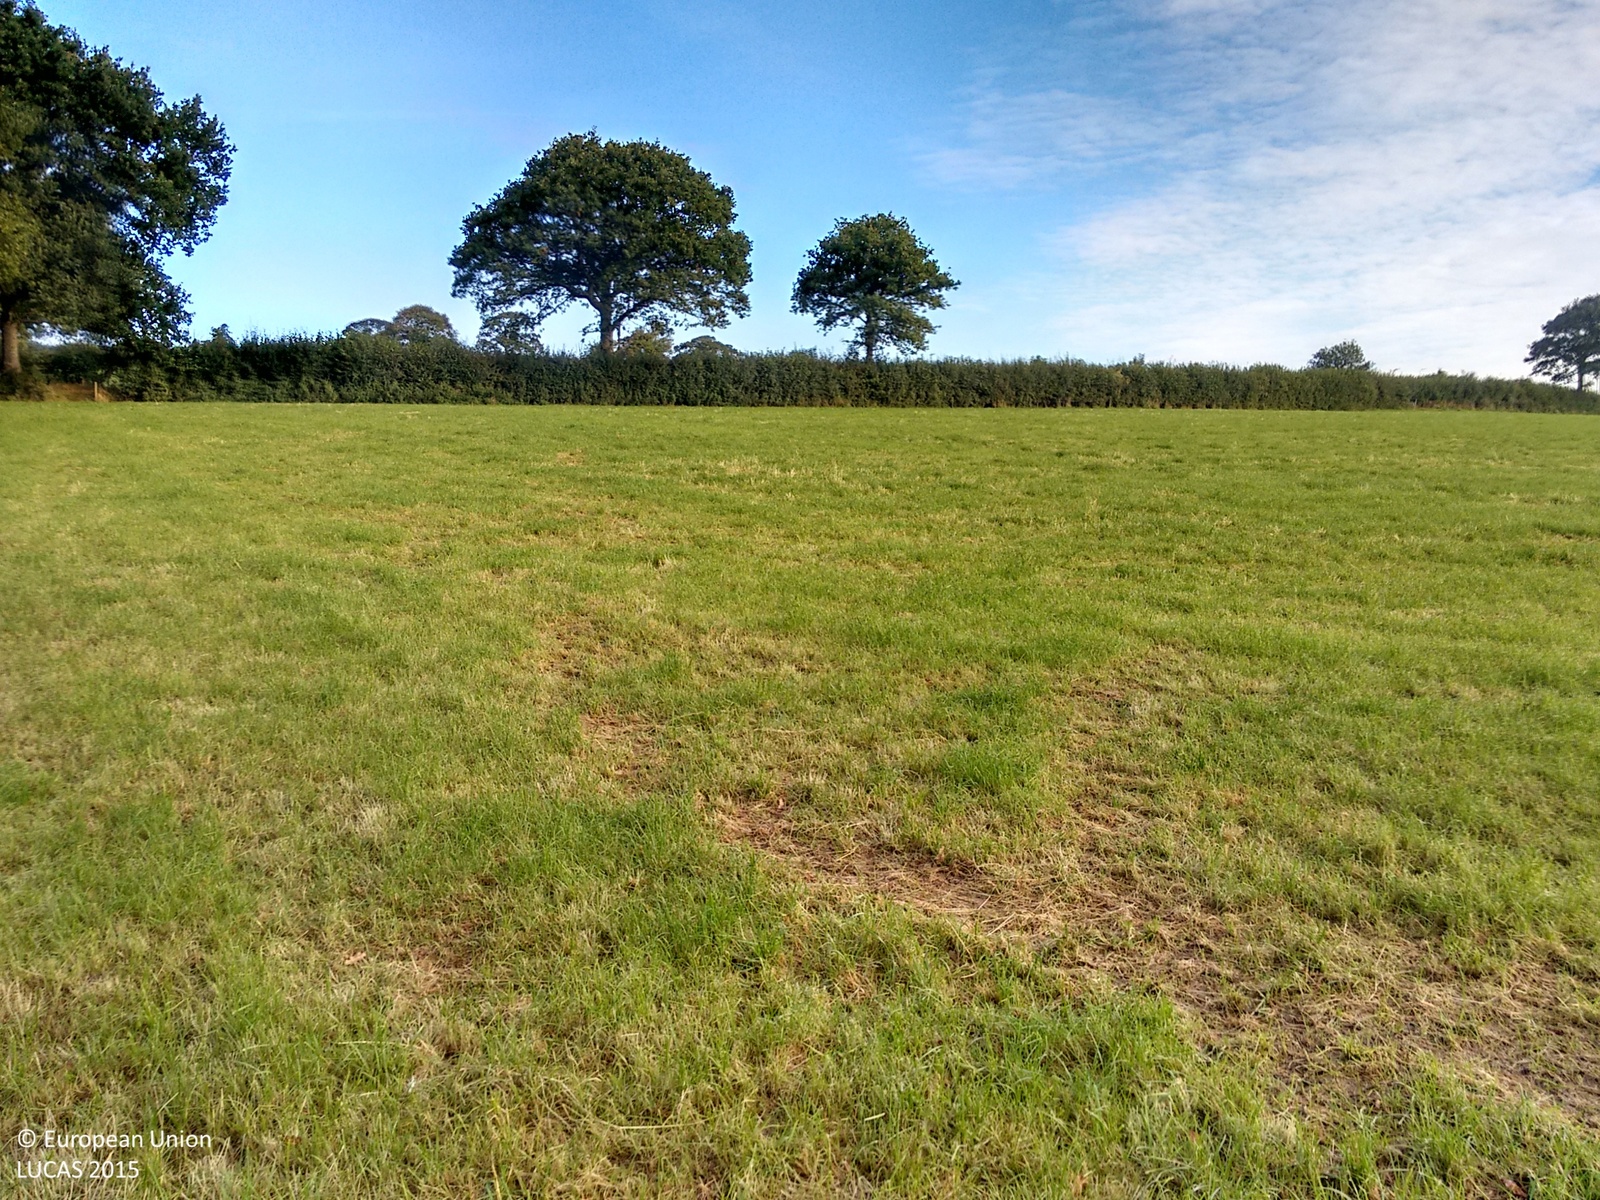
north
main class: Grassland
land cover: Grassland without tree/shrub cover
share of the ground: 50 - 75 %
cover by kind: herbaceous plants 60 %, unconsolidated bare surface 40 %
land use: Agriculture (excluding fallow land and kitchen gardens)
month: September
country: GB
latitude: 50.6698
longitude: -4.2628
